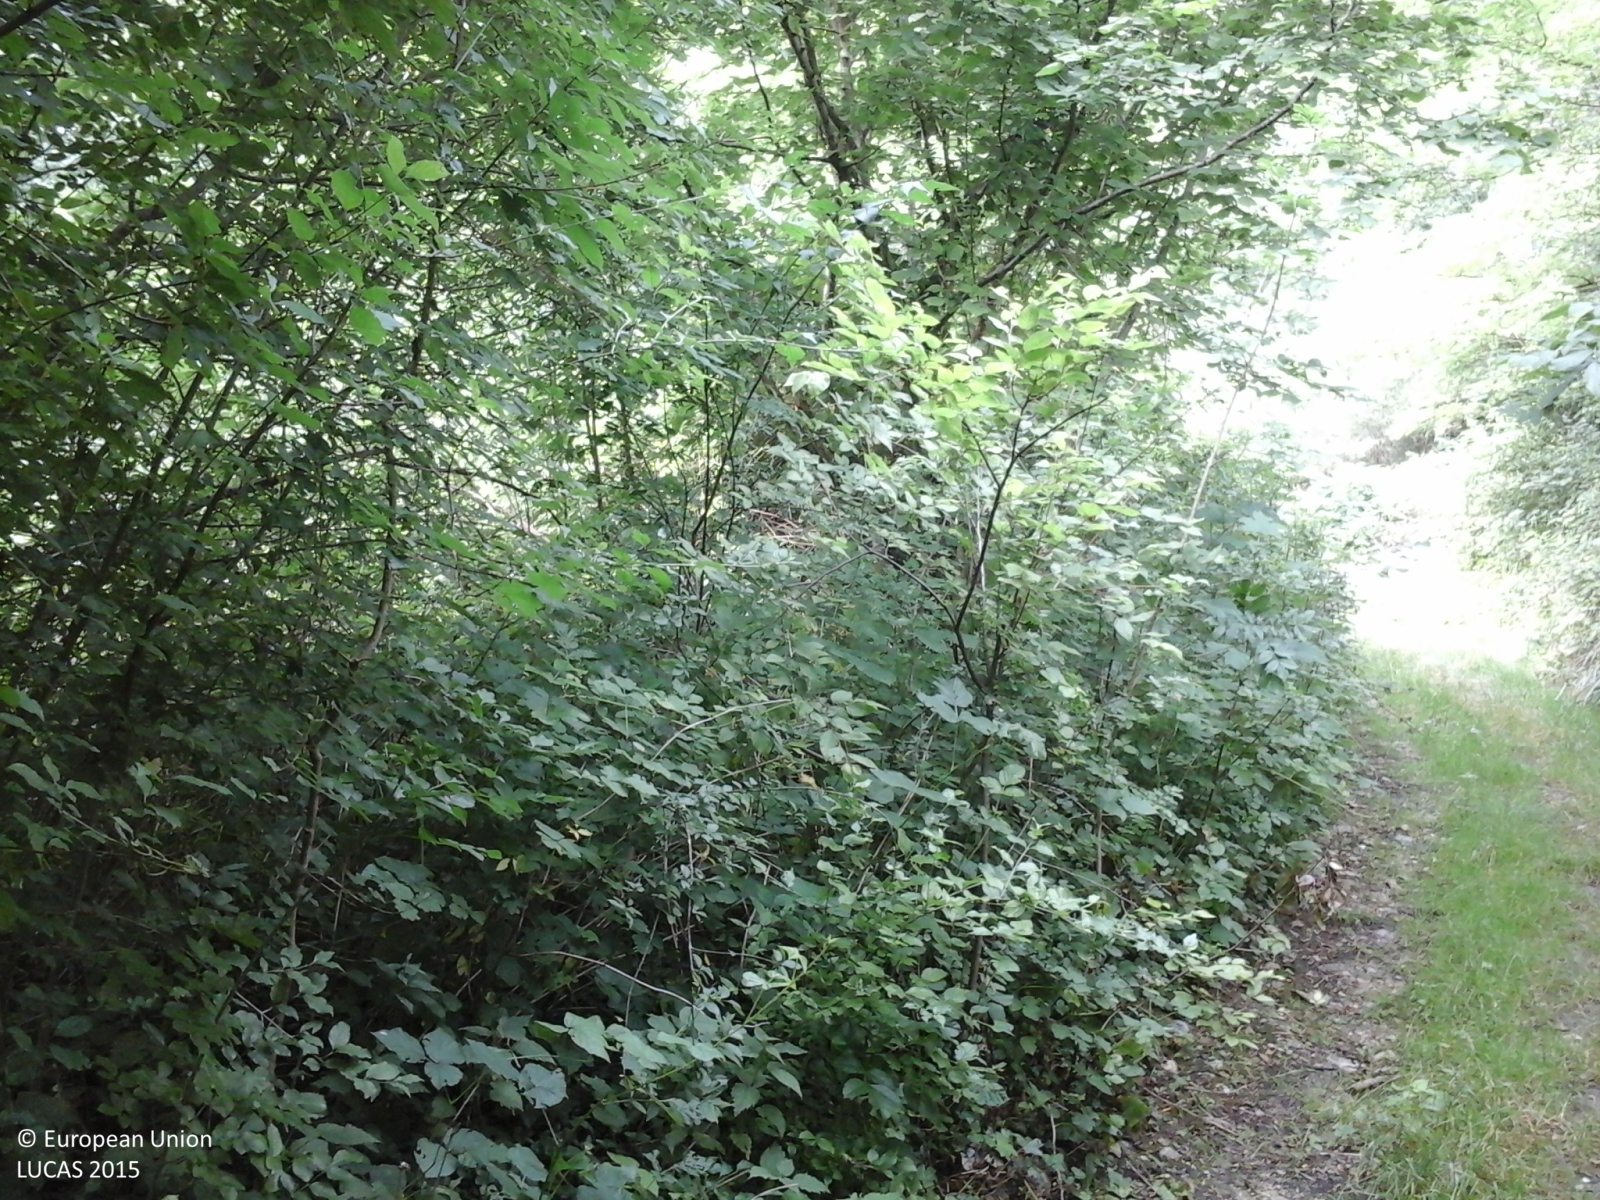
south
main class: Woodland
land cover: Broadleaved woodland
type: thermophilous deciduous forest
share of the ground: > 75 %
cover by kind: broadleaved forest trees 100 %
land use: Semi-natural and natural areas not in use
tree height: > 5 m
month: June
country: IT
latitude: 46.0014
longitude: 12.3341
